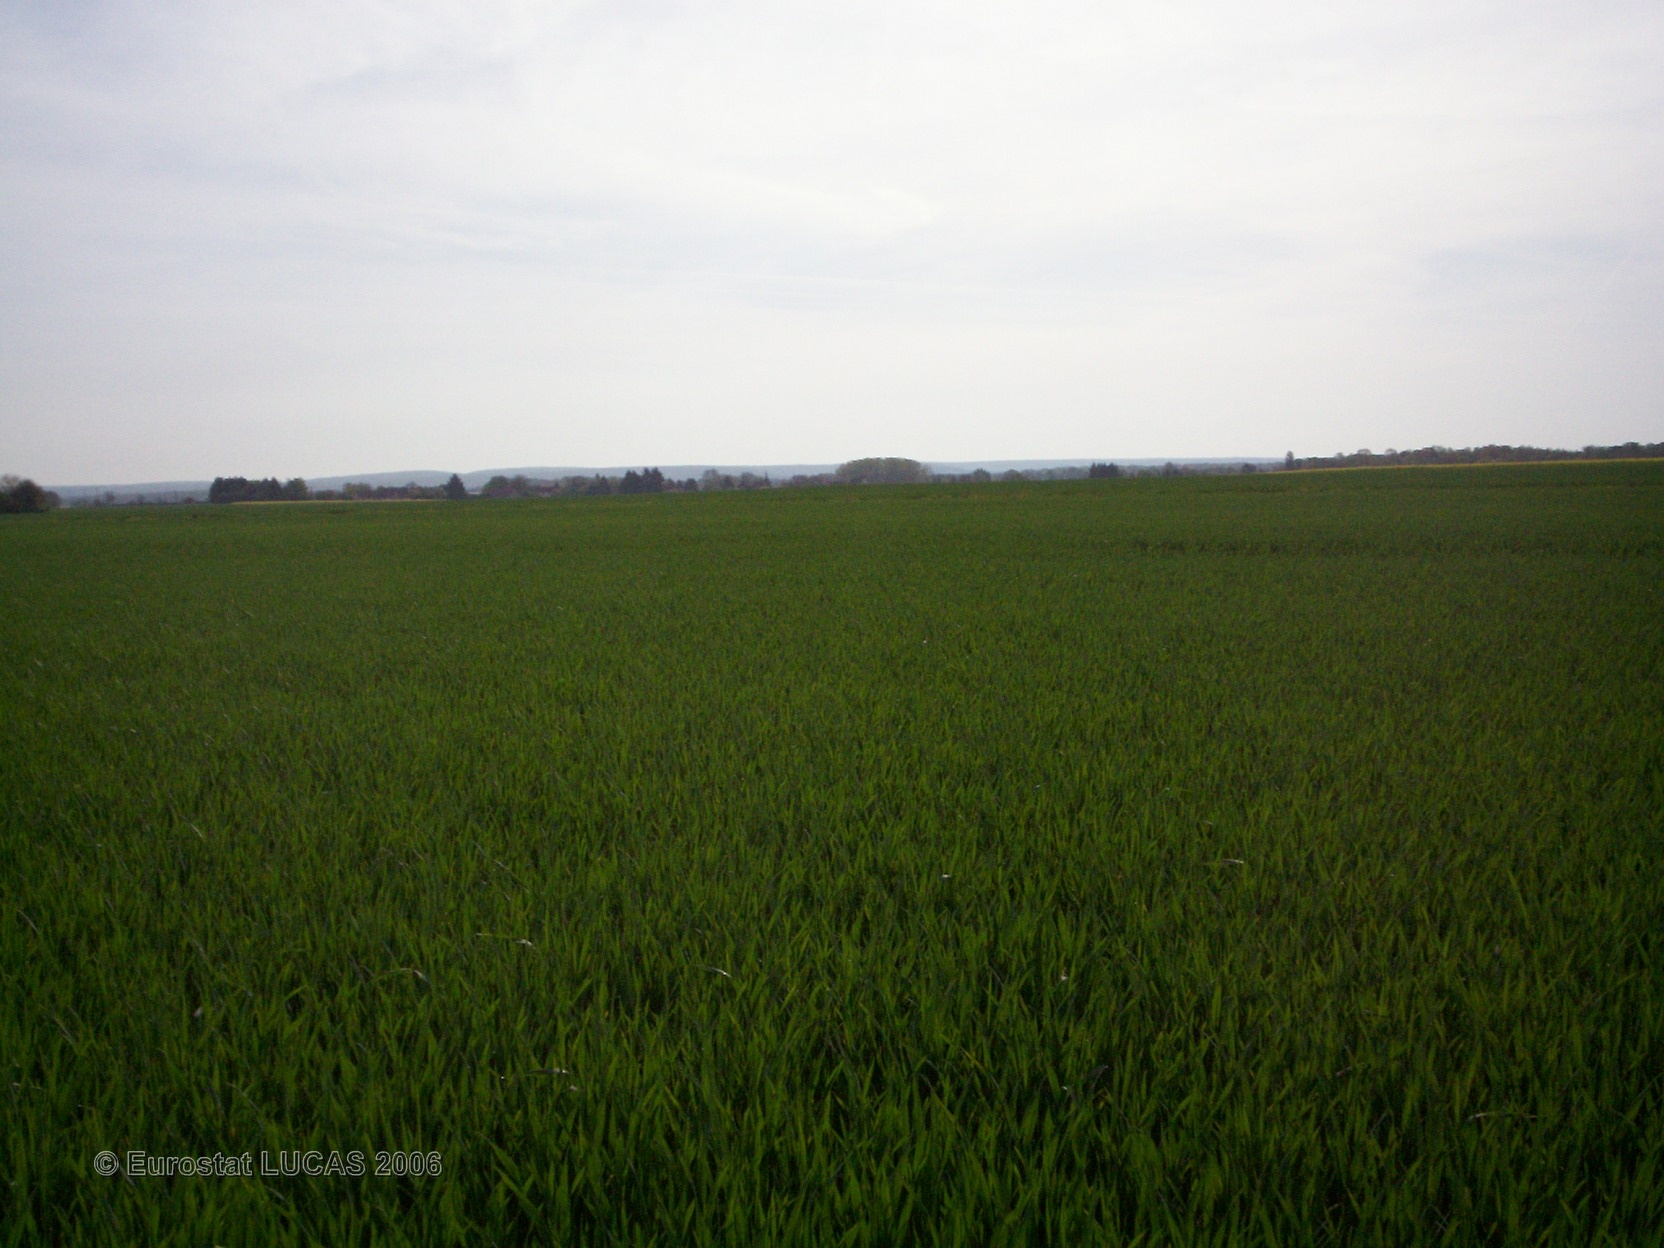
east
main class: Cropland
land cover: Common wheat
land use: Agriculture (excluding fallow land and kitchen gardens)
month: May
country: FR
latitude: 47.2639
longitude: 3.0566
